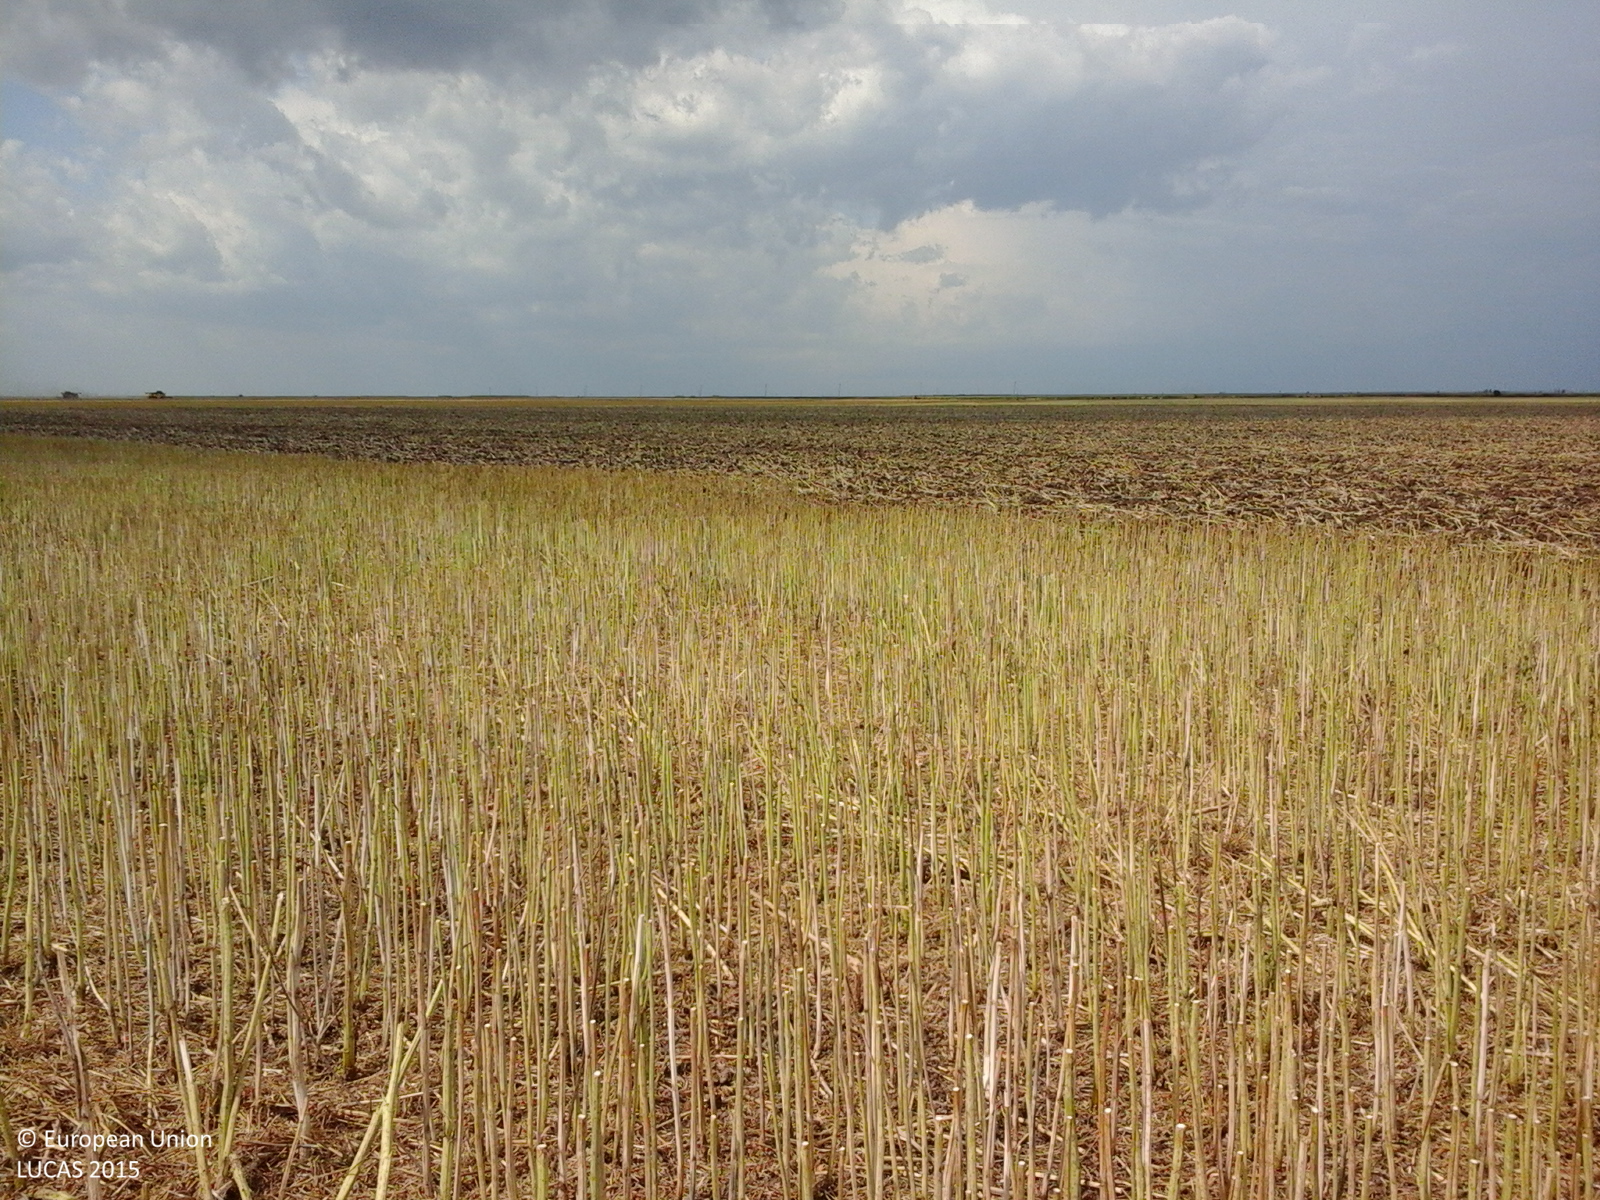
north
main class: Cropland
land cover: Rape and turnip rape
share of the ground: < 10 %
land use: Agriculture (excluding fallow land and kitchen gardens)
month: July
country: RO
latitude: 43.8871
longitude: 24.5424
